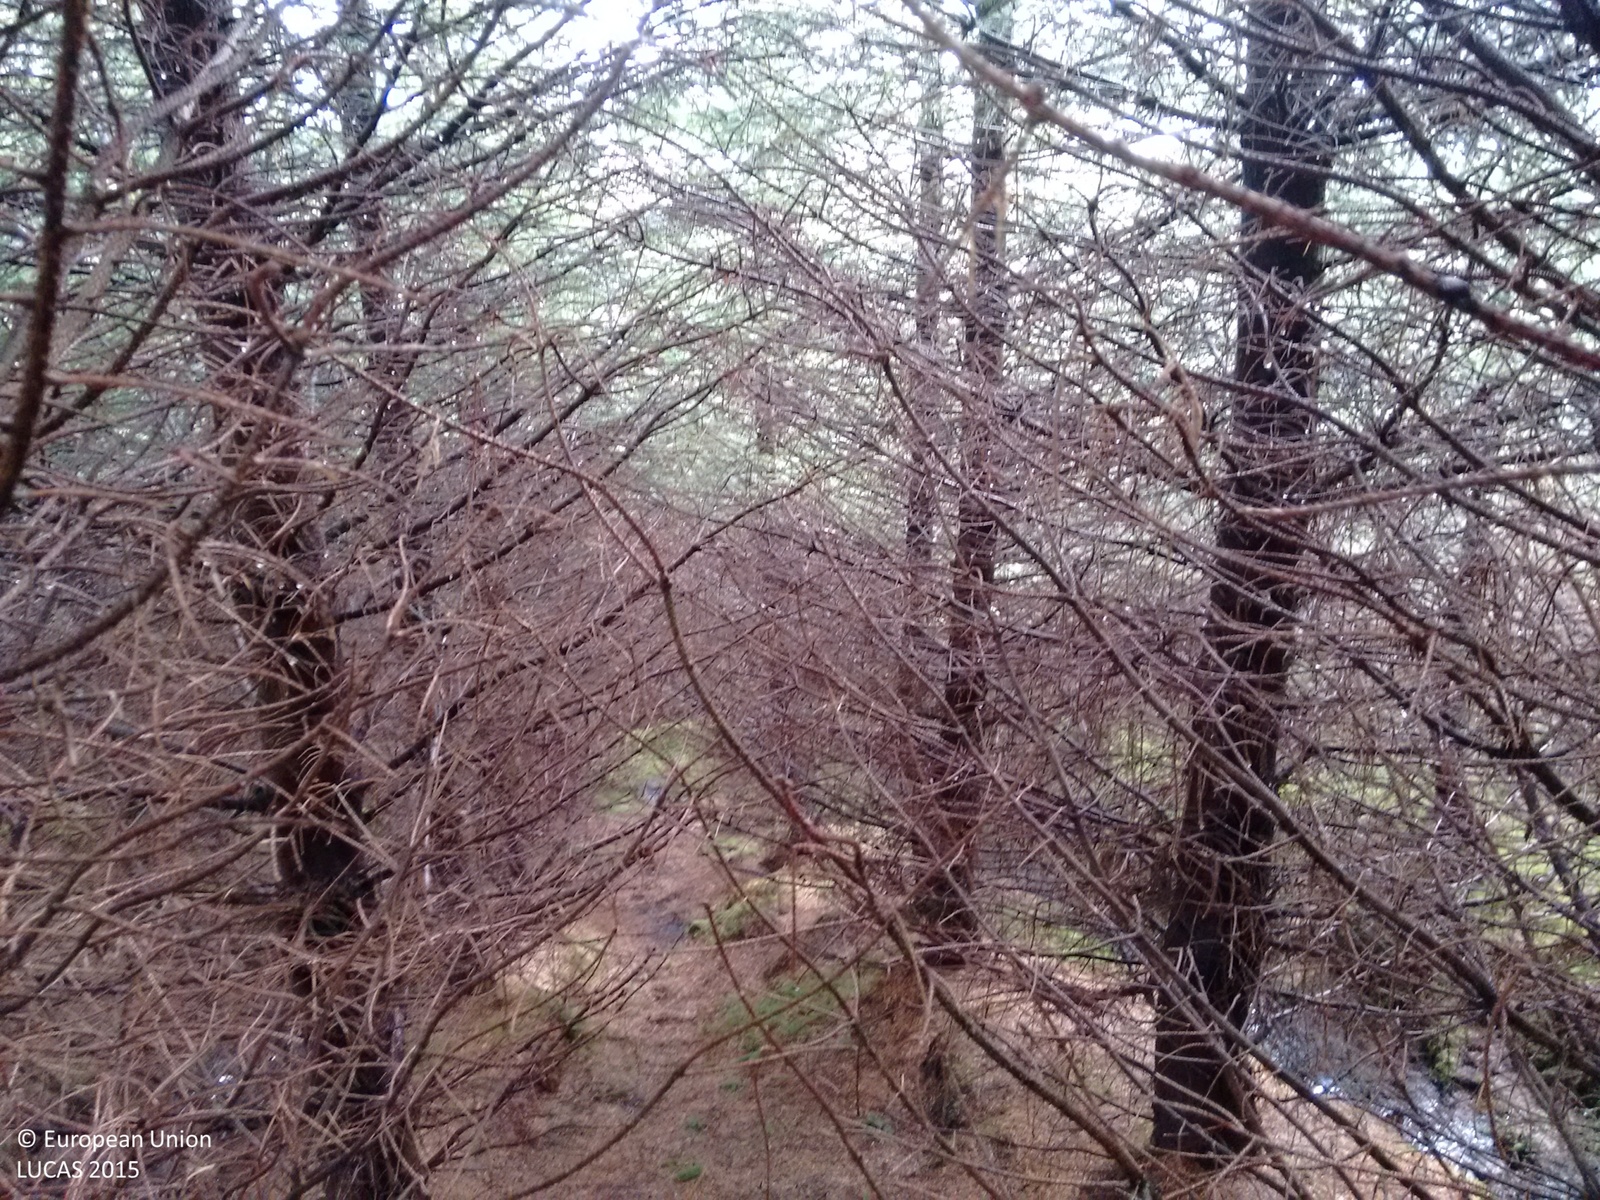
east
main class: Woodland
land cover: Spruce dominated coniferous woodland
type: exotic forest
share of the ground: > 75 %
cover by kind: coniferous forest trees 100 %
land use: Forestry
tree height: > 5 m
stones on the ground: < 10 %
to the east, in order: Spruce dominated coniferous woodland; Grassland without tree/shrub cover; Rivers and streams; Grassland without tree/shrub cover; Tracks; Grassland without tree/shrub cover; Ditches and canals; Grassland without tree/shrub cover; Spruce dominated coniferous woodland; Grassland without tree/shrub cover; Electric lines; Grassland without tree/shrub cover; Spruce dominated coniferous woodland; Ditches and canals; Spruce dominated coniferous woodland
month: May
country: GB
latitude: 56.1098
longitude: -5.1152
